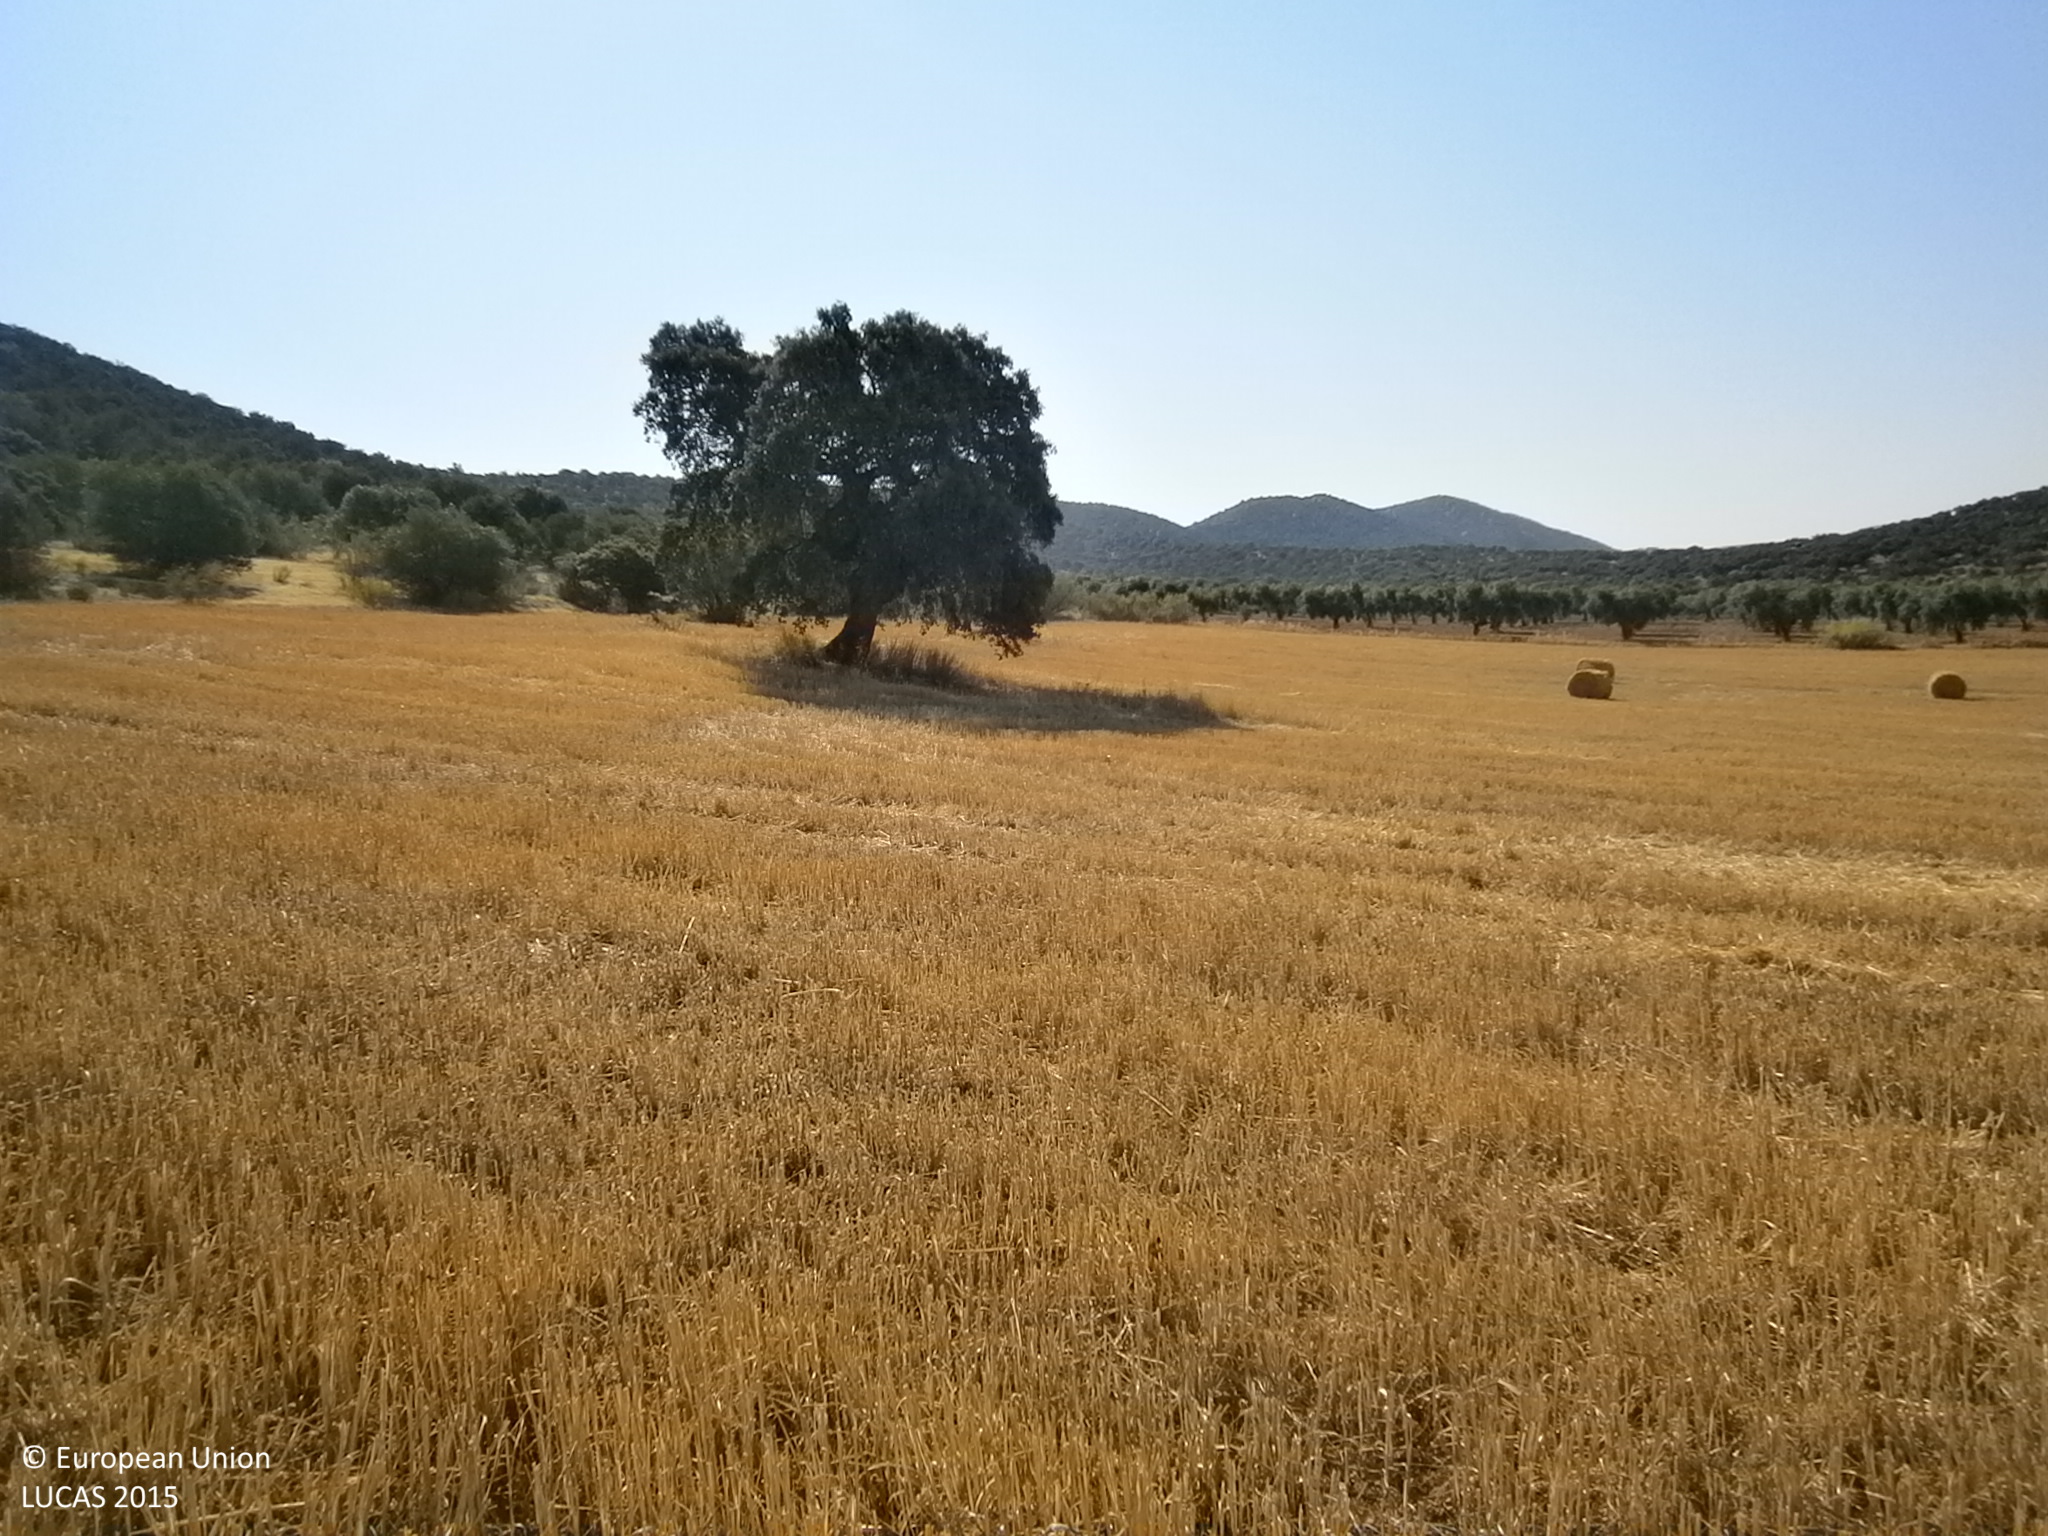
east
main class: Cropland
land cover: Dry pulses
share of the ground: > 75 %
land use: Agriculture (excluding fallow land and kitchen gardens)
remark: Harvested field
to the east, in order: Dry pulses; Grassland without tree/shrub cover; Olive groves
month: June
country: ES
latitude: 38.5781
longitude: -6.7382
